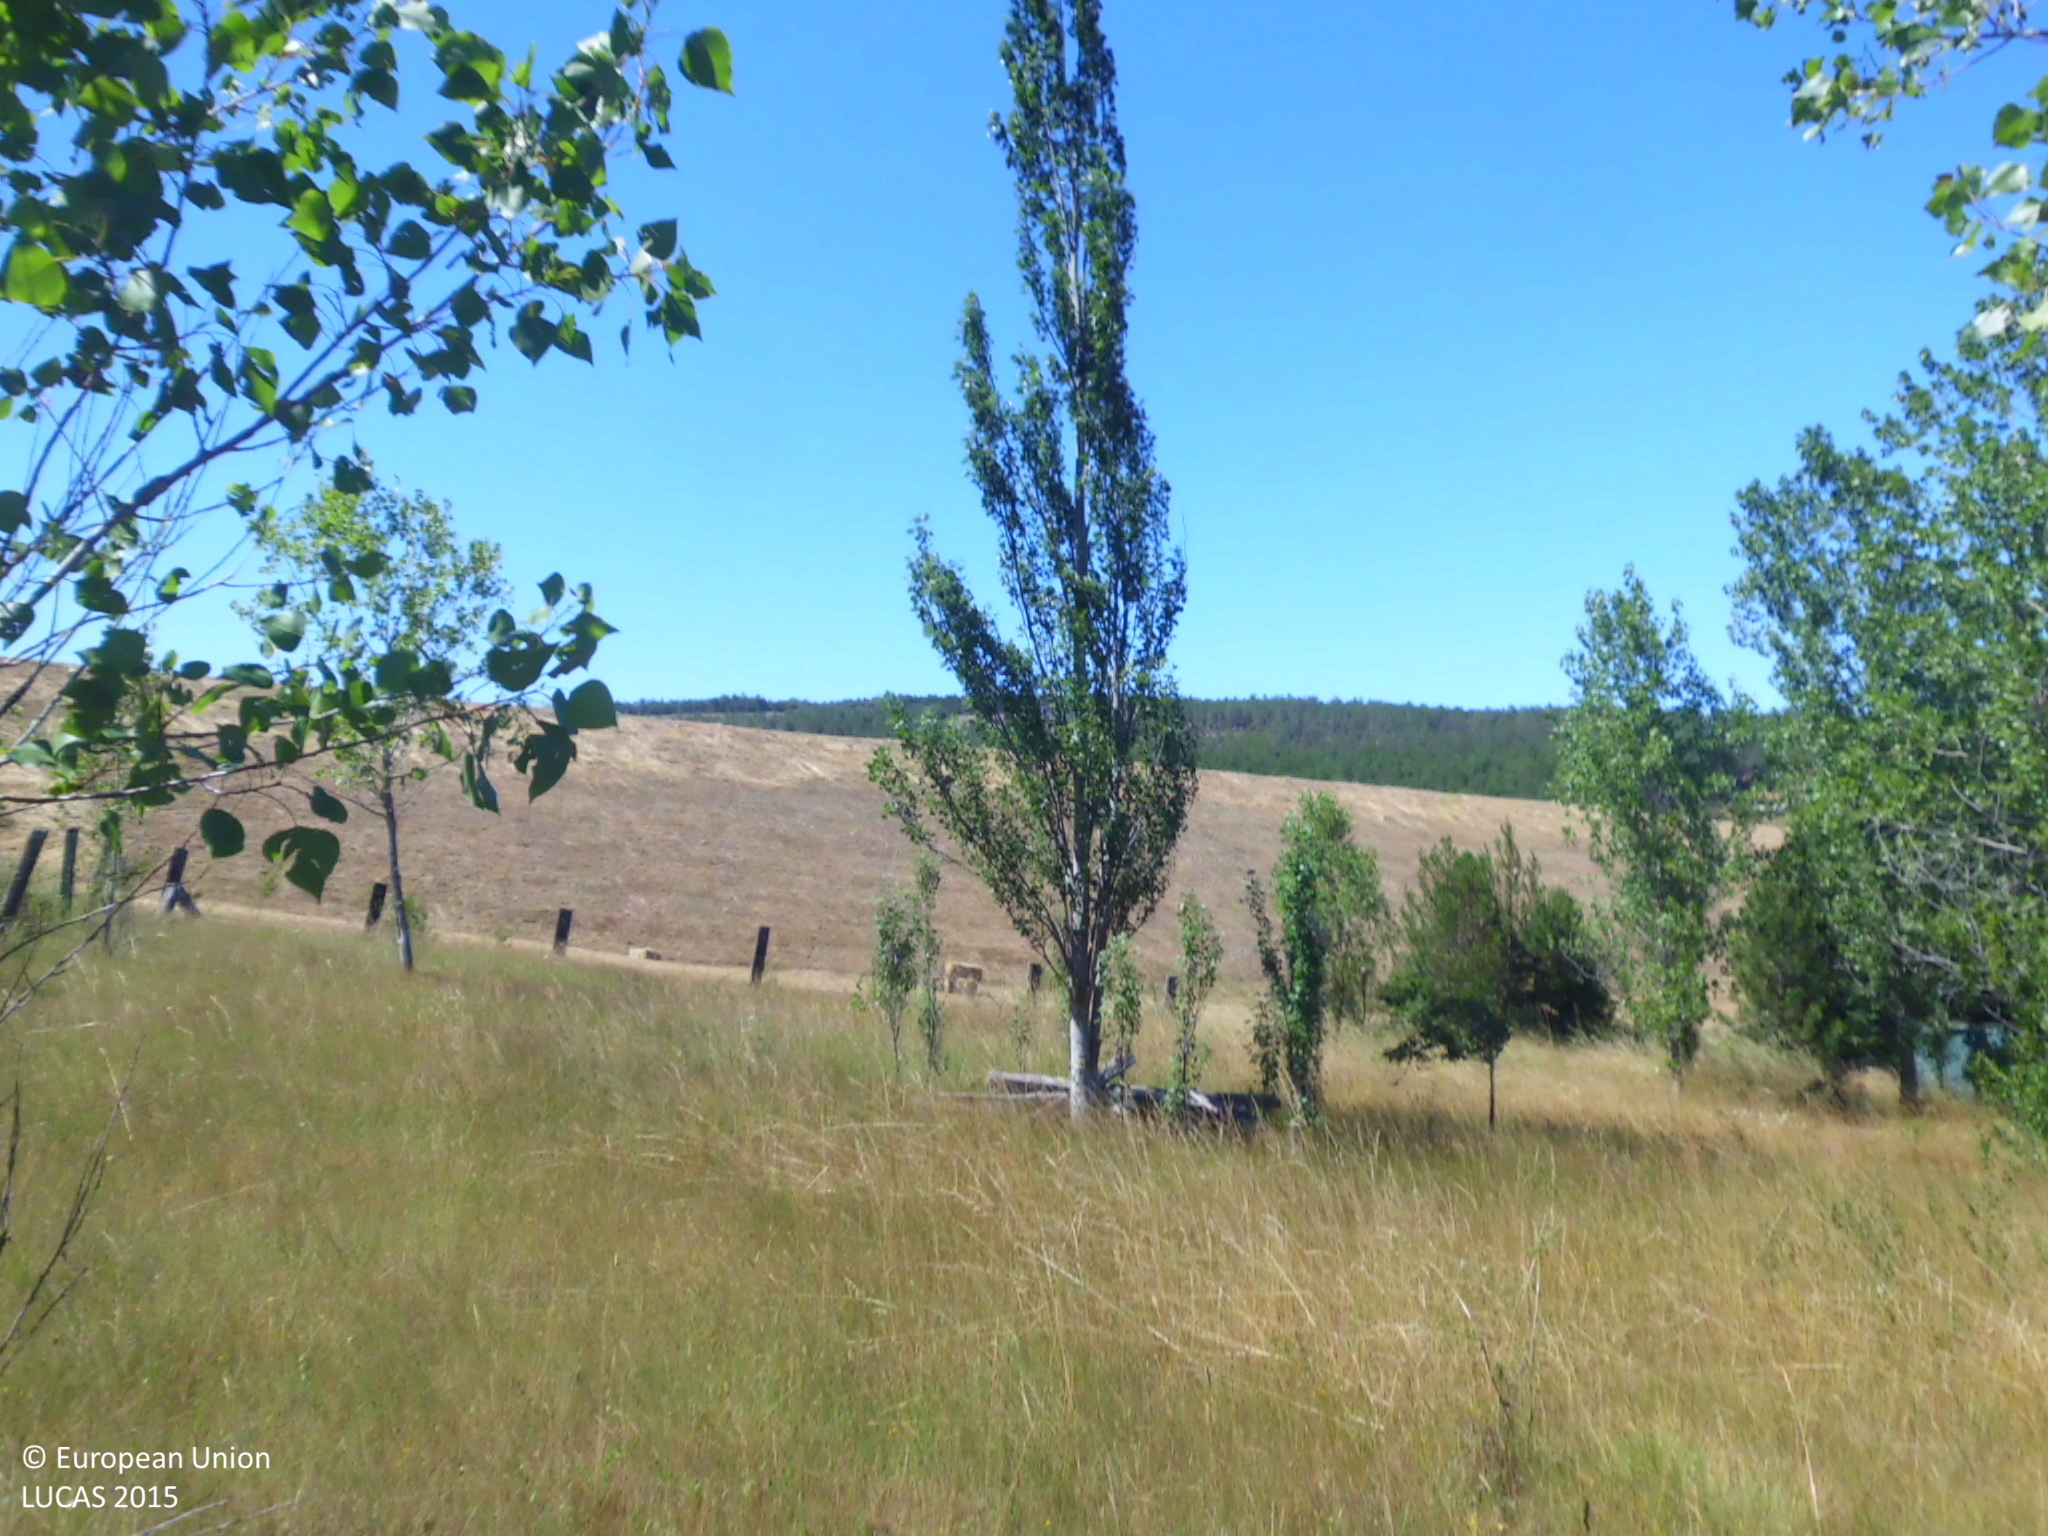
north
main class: Grassland
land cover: Grassland with sparse tree/shrub cover
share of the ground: > 75 %
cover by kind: herbaceous plants 95 %, broadleaved forest trees 5 %
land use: Semi-natural and natural areas not in use
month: July
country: ES
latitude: 42.7879
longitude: -4.2924
